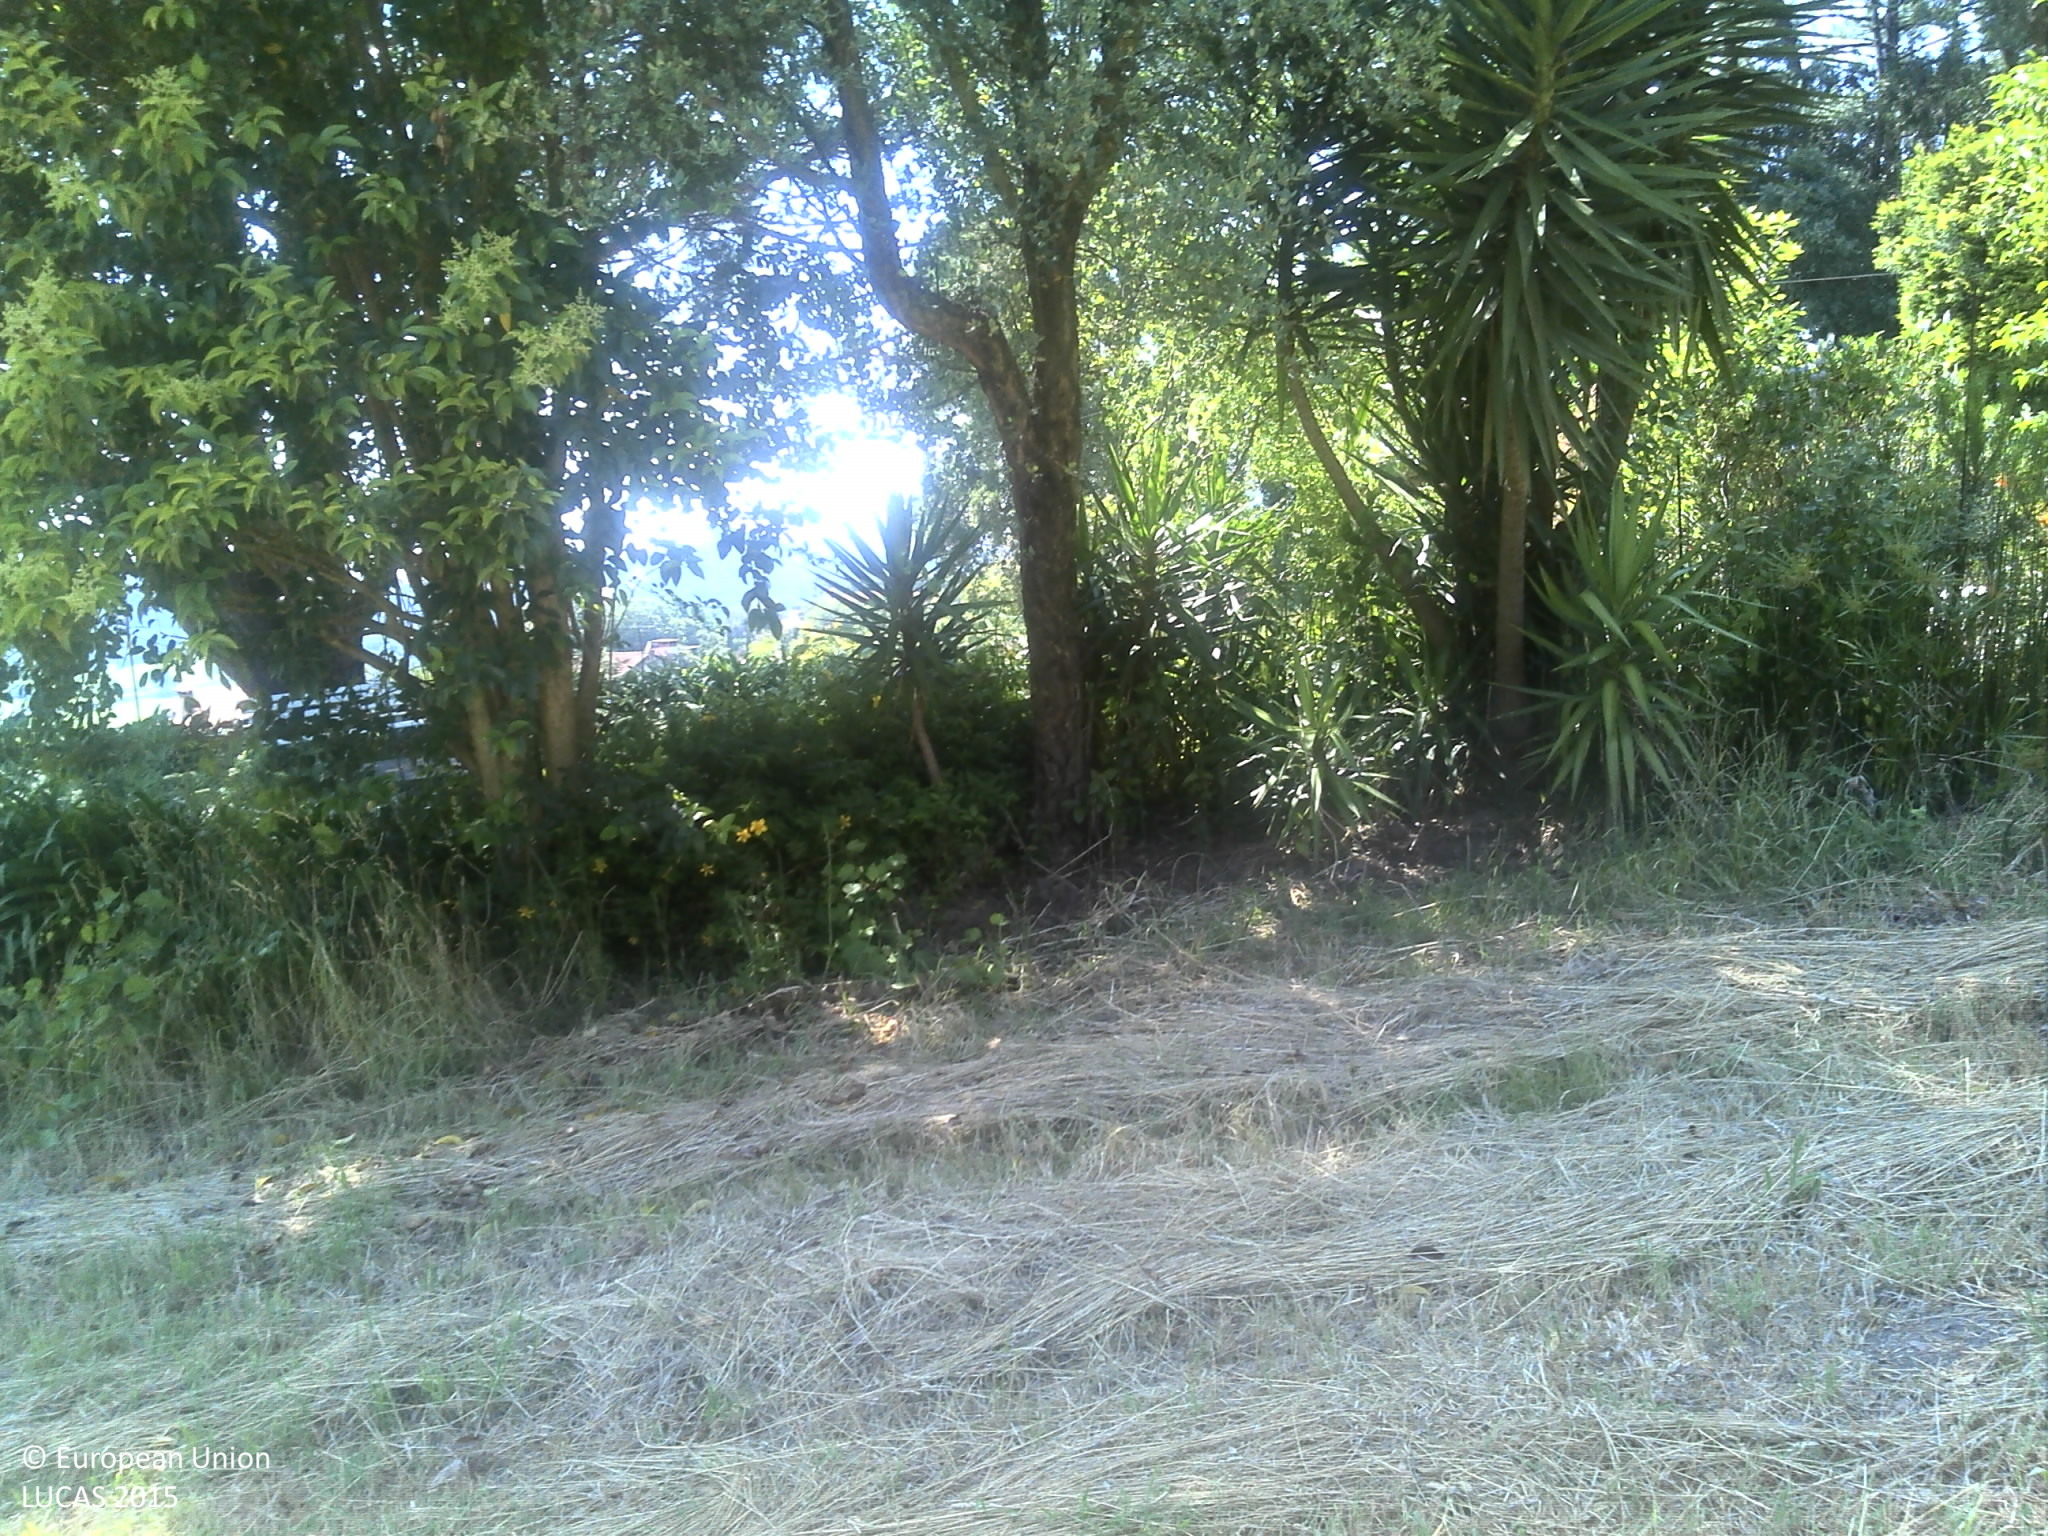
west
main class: Cropland
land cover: Temporary grasslands
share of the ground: > 75 %
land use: Agriculture (excluding fallow land and kitchen gardens)
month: June
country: PT
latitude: 41.5361
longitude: -8.5315
